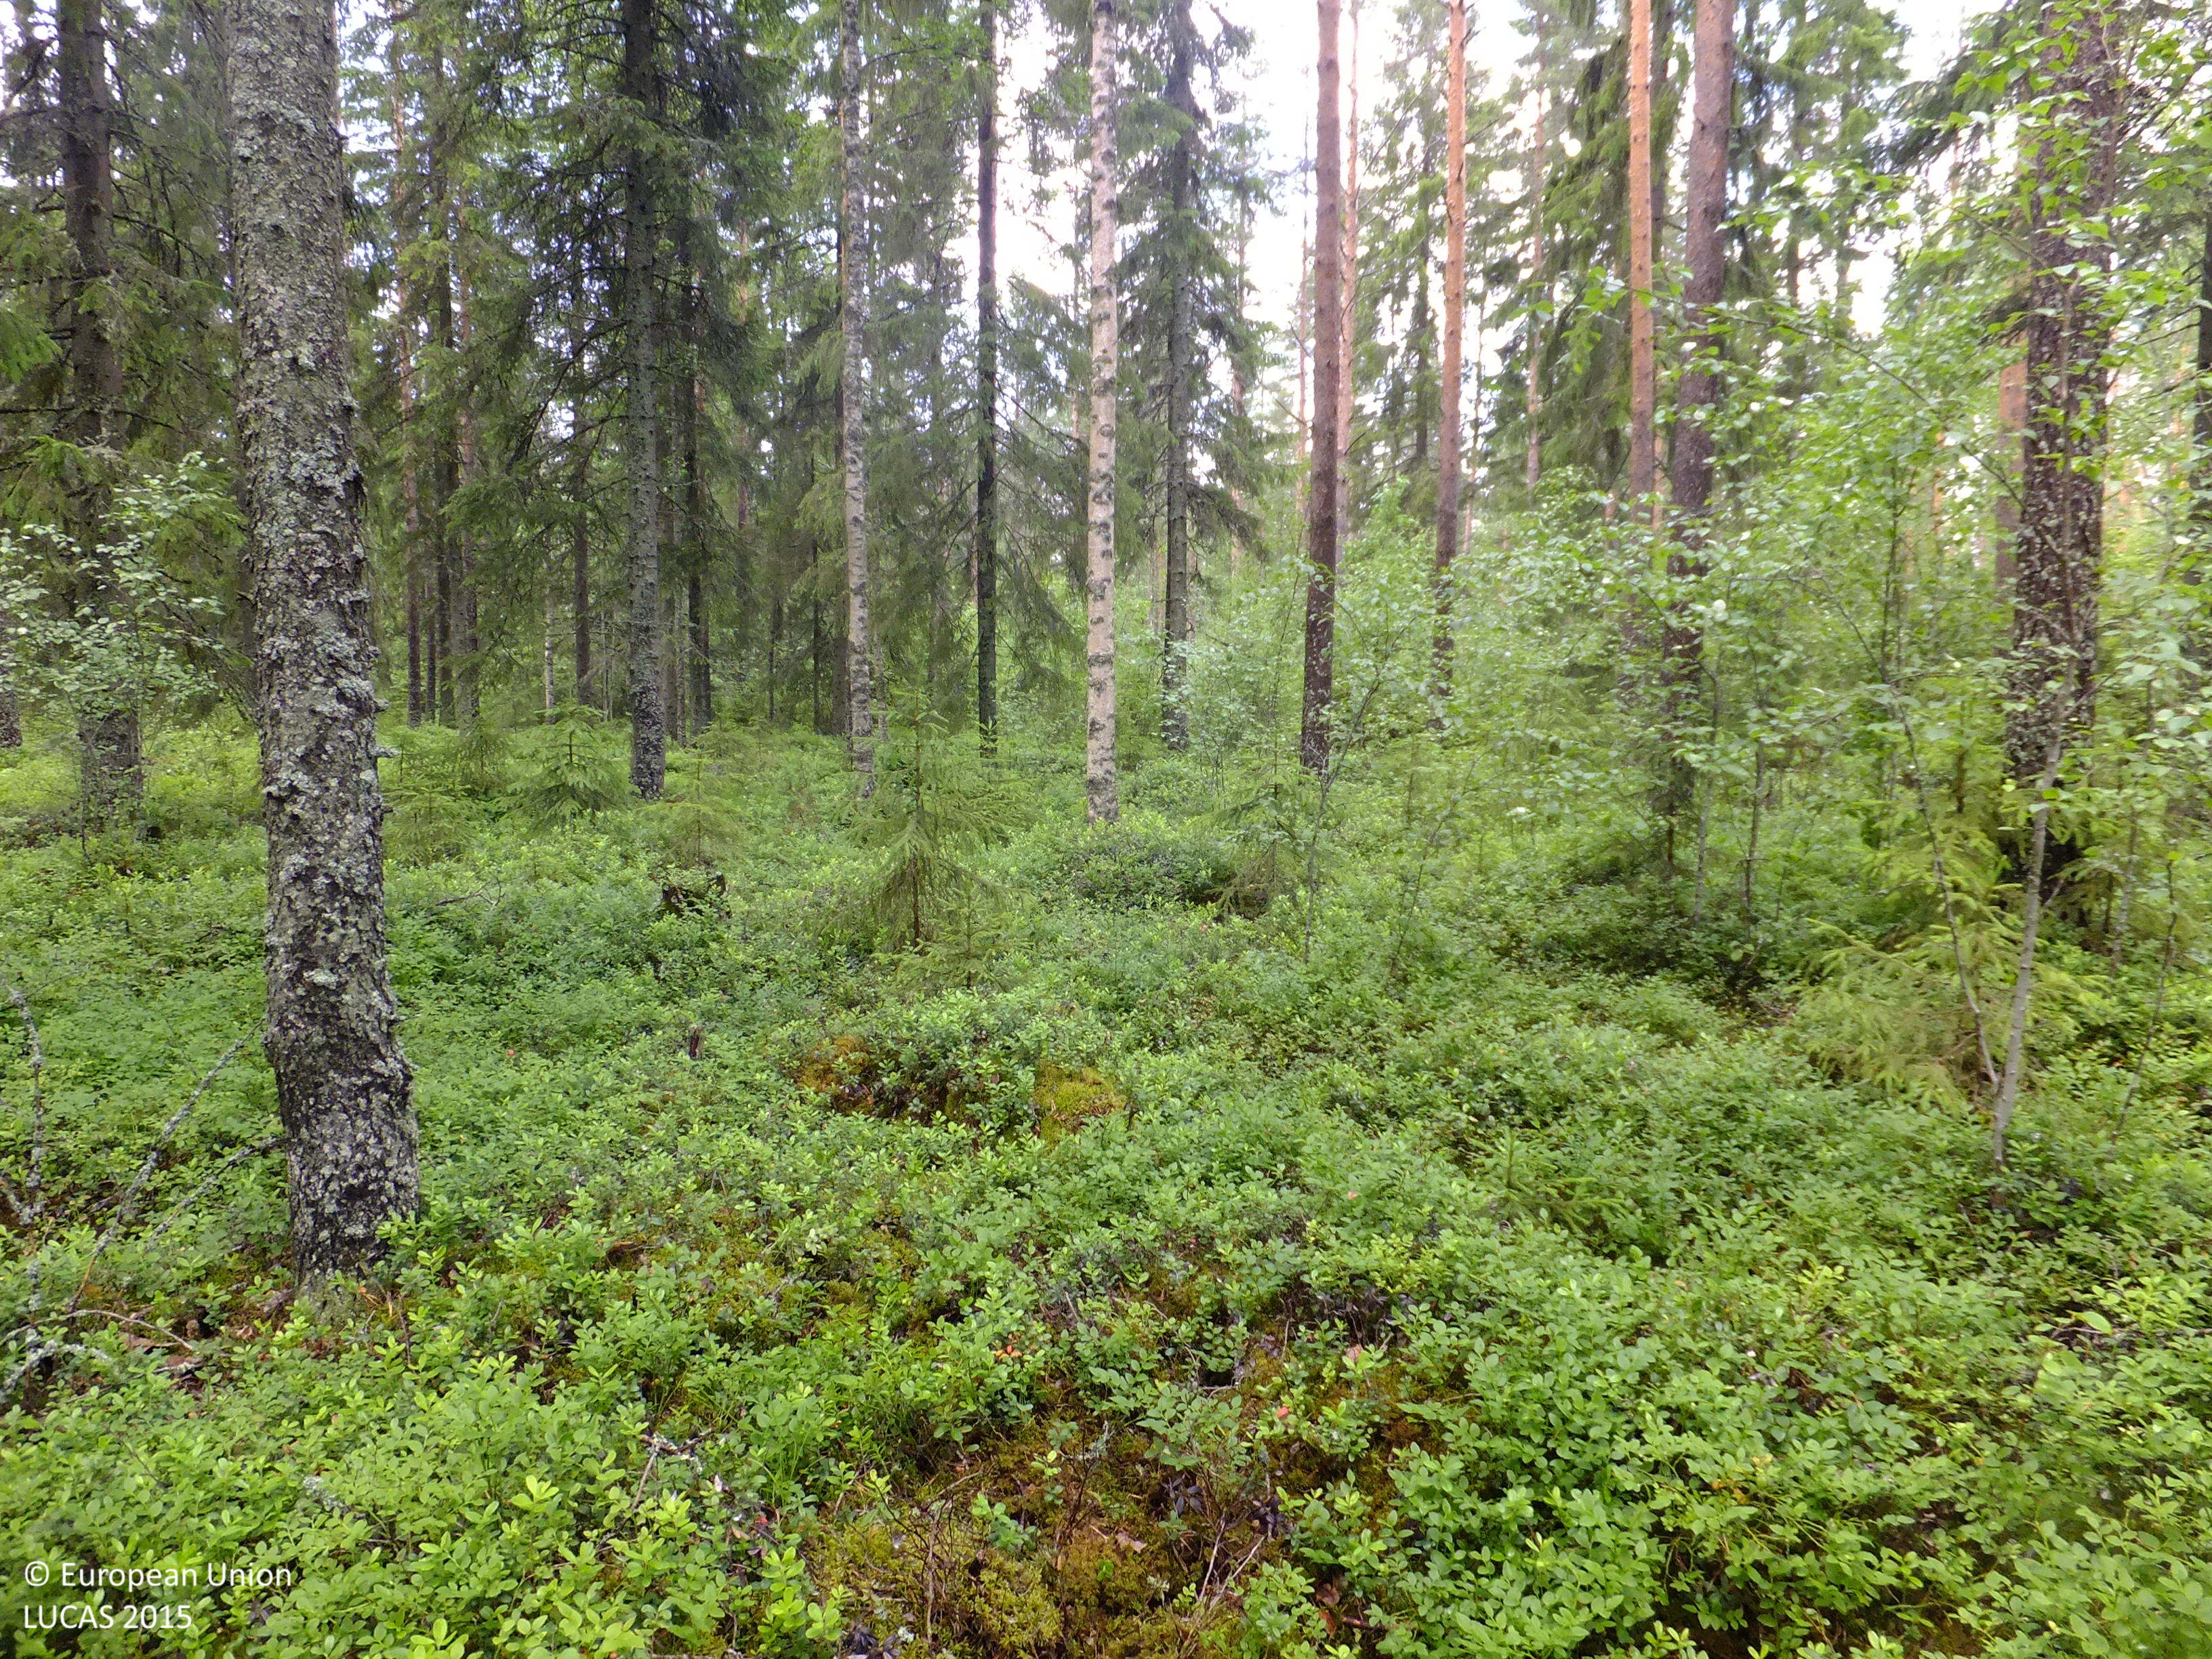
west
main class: Woodland
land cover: Other mixed woodland
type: boreal forest
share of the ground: > 75 %
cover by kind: broadleaved forest trees 50 %, coniferous forest trees 35 %, shrubs 10 %, herbaceous plants 5 %
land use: Forestry
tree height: > 5 m
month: July
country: FI
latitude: 63.0949
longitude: 24.5649
